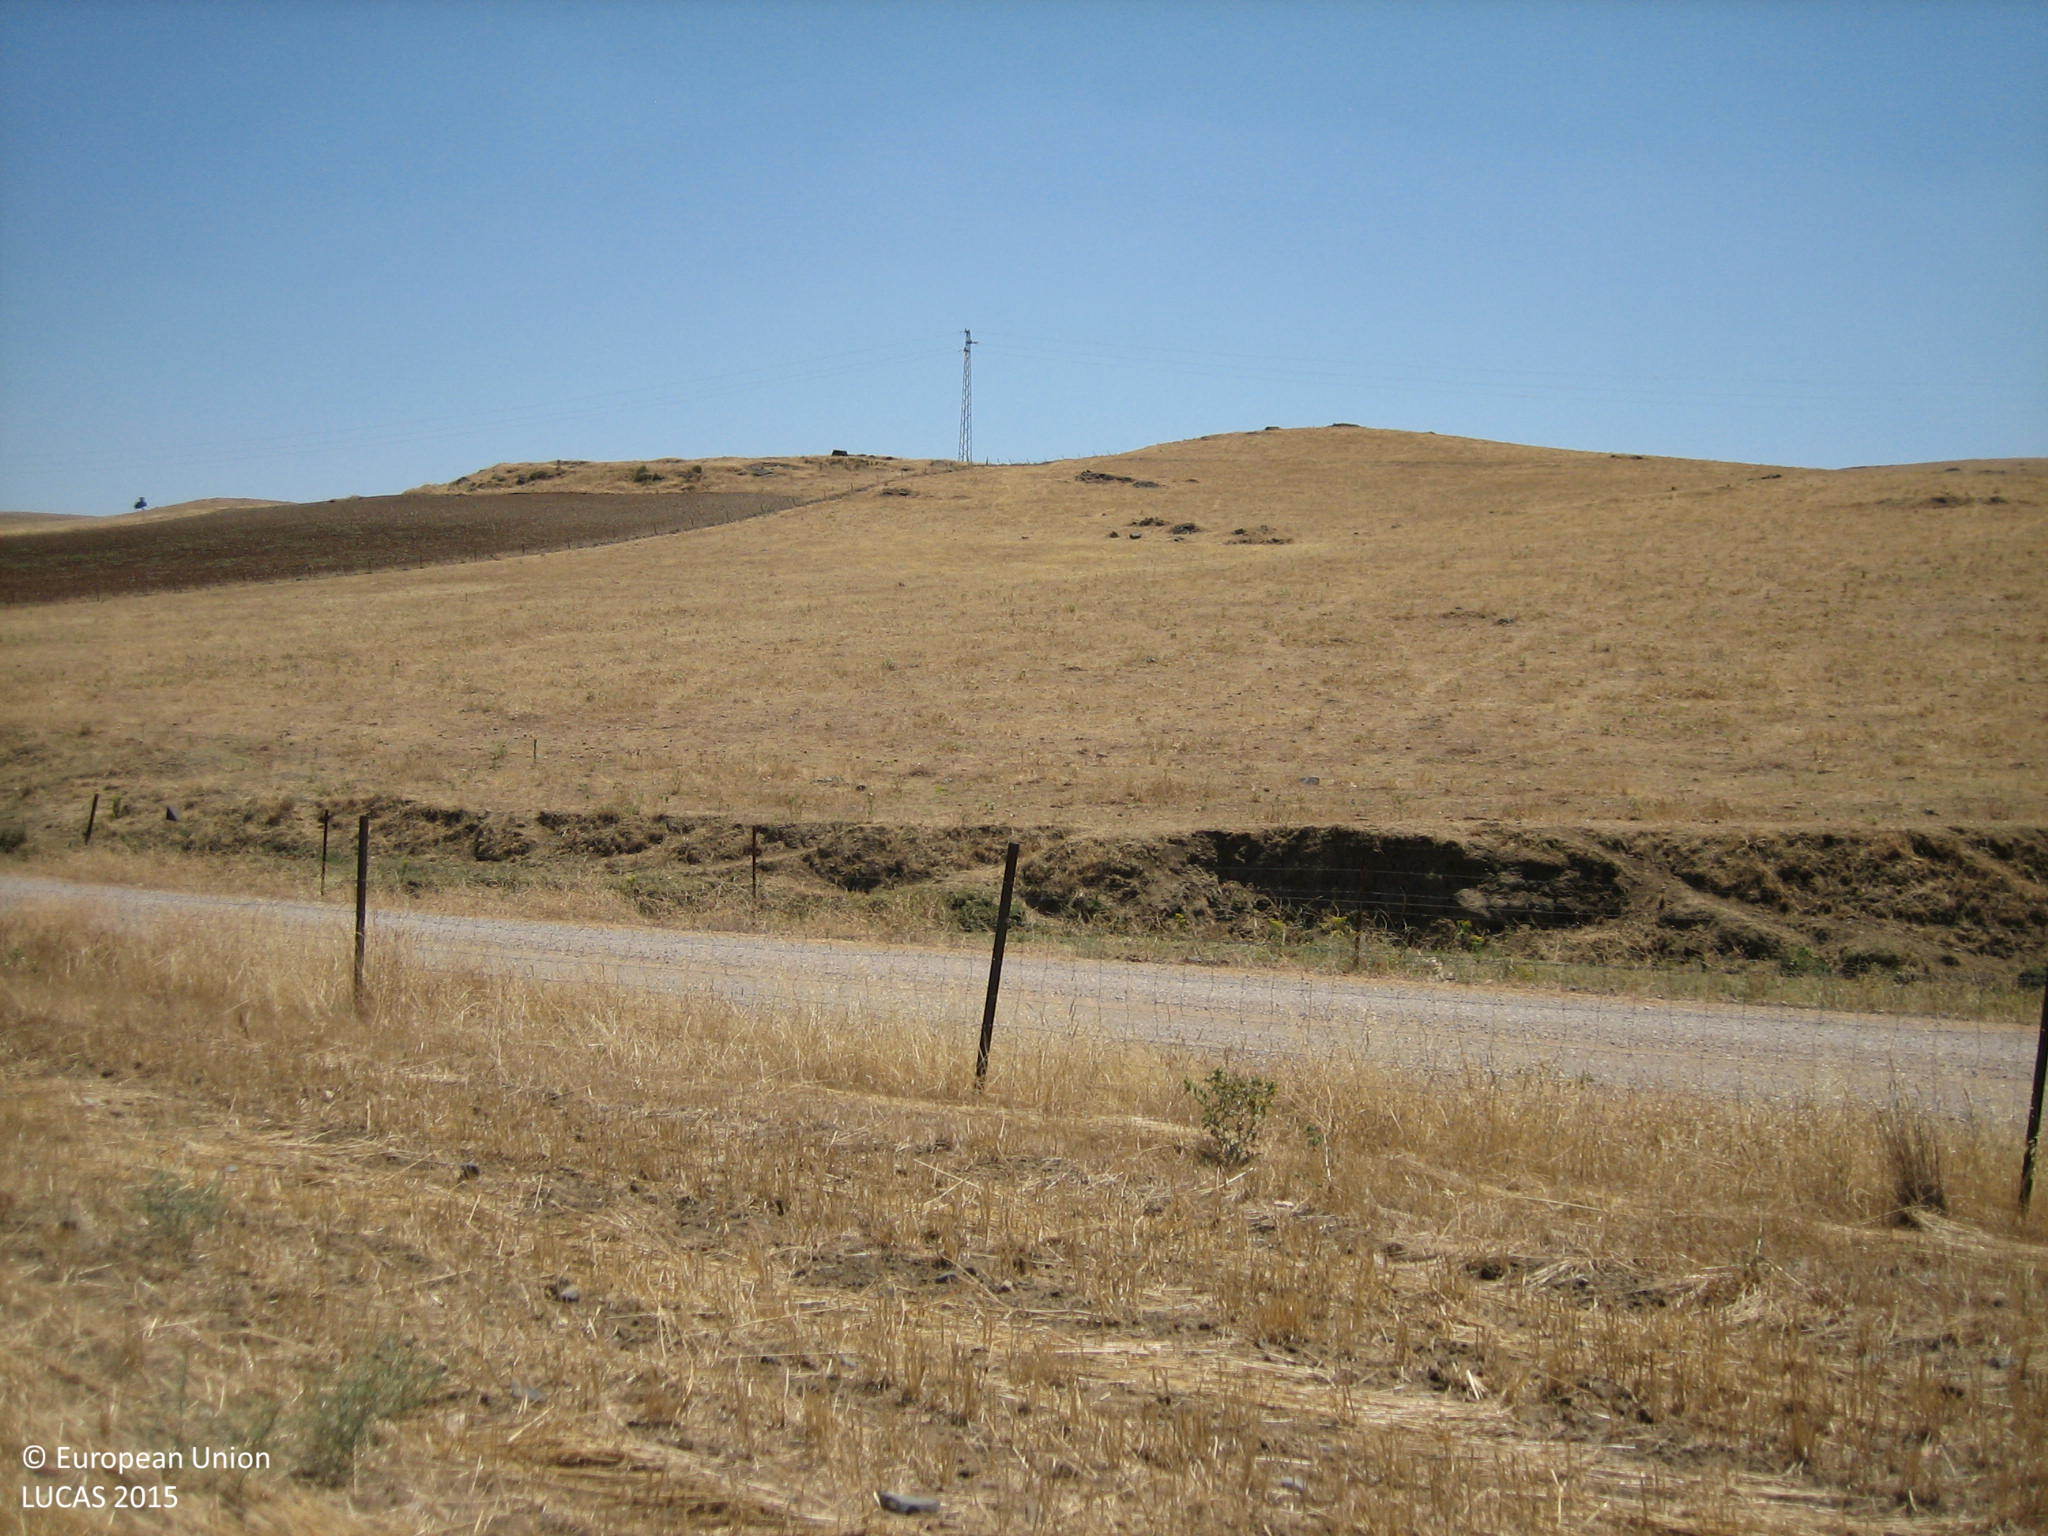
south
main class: Cropland
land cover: Common wheat
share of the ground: < 10 %
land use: Agriculture (excluding fallow land and kitchen gardens)
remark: Harvested field
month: July
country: ES
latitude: 38.1635
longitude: -6.2612
